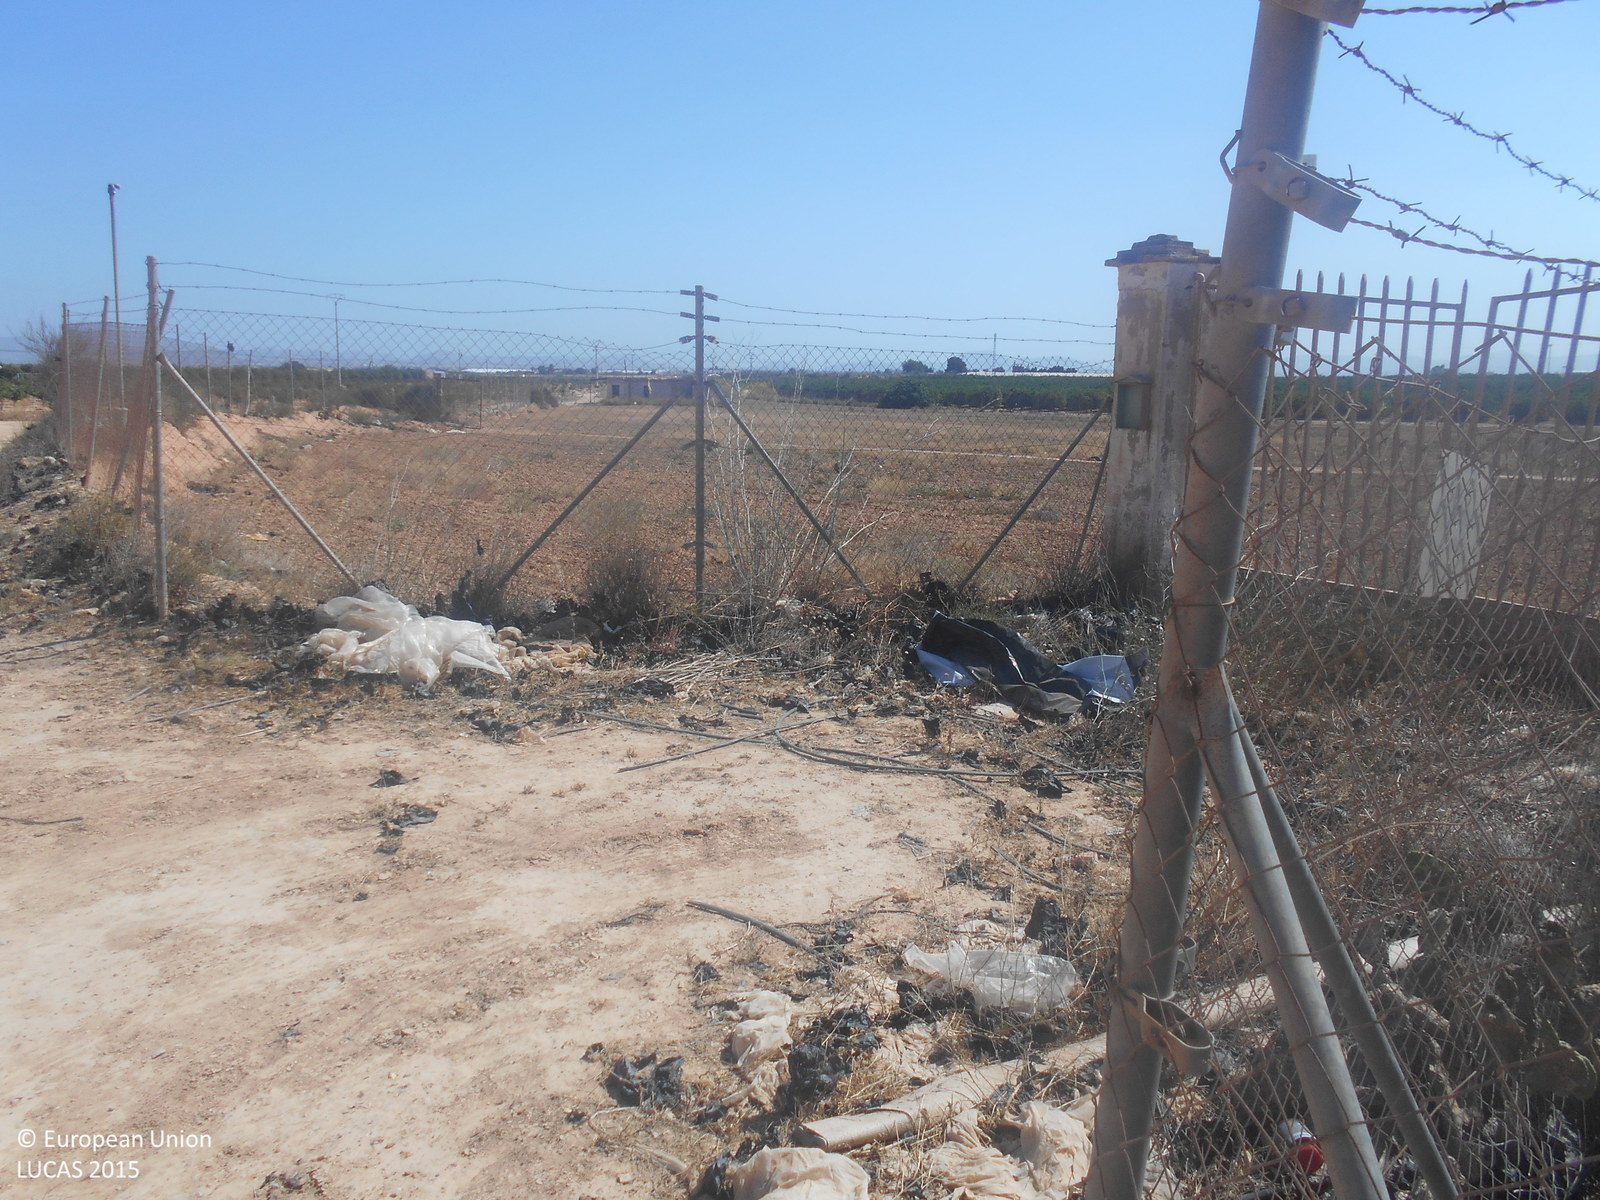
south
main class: Grassland
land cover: Grassland without tree/shrub cover
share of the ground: 10 - 25 %
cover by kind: unconsolidated bare surface 85 %, herbaceous plants 15 %
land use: Agriculture (excluding fallow land and kitchen gardens)
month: May
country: ES
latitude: 37.7910
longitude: -0.9390
